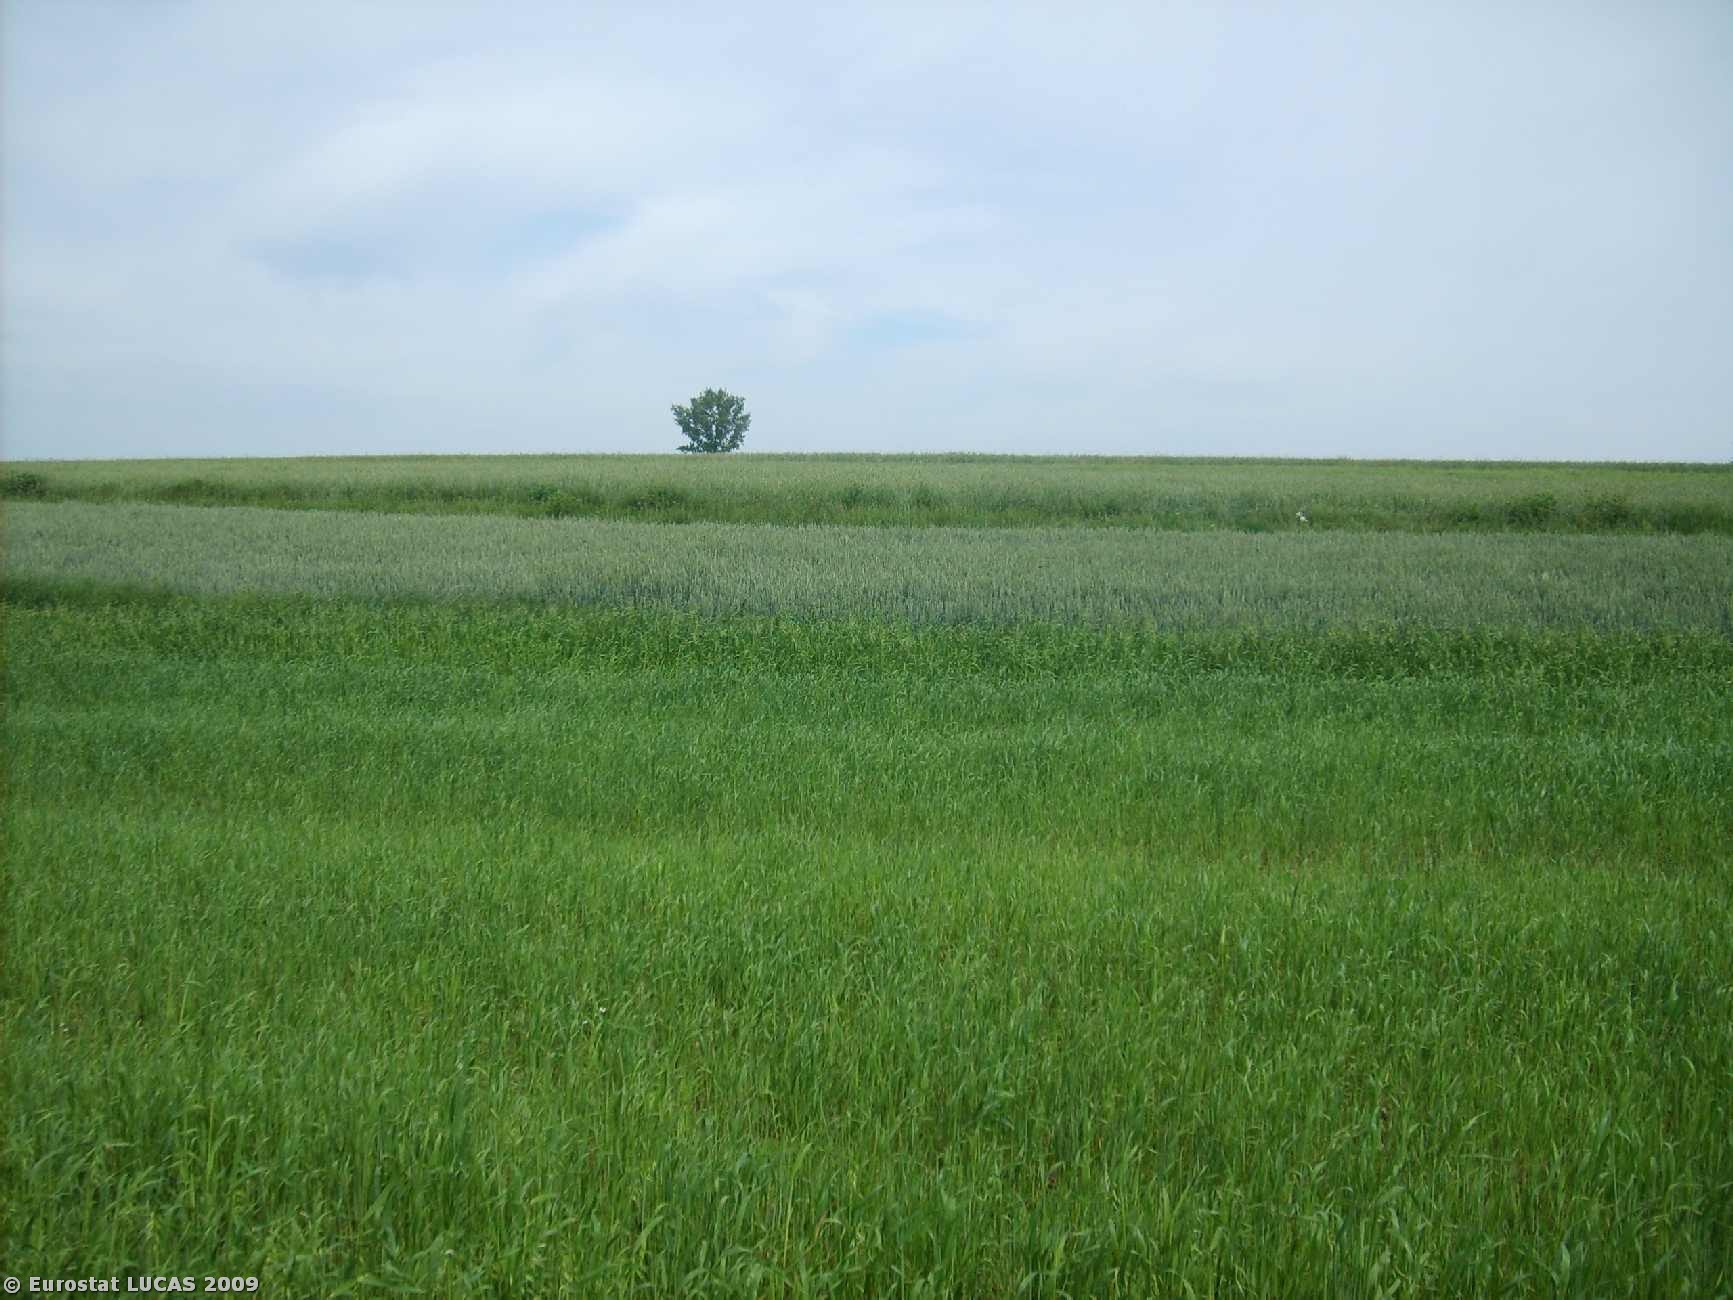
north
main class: Cropland
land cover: Oats
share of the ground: > 75 %
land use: Agriculture (excluding fallow land and kitchen gardens)
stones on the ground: < 10 %
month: June
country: PL
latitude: 51.0005
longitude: 22.3616
